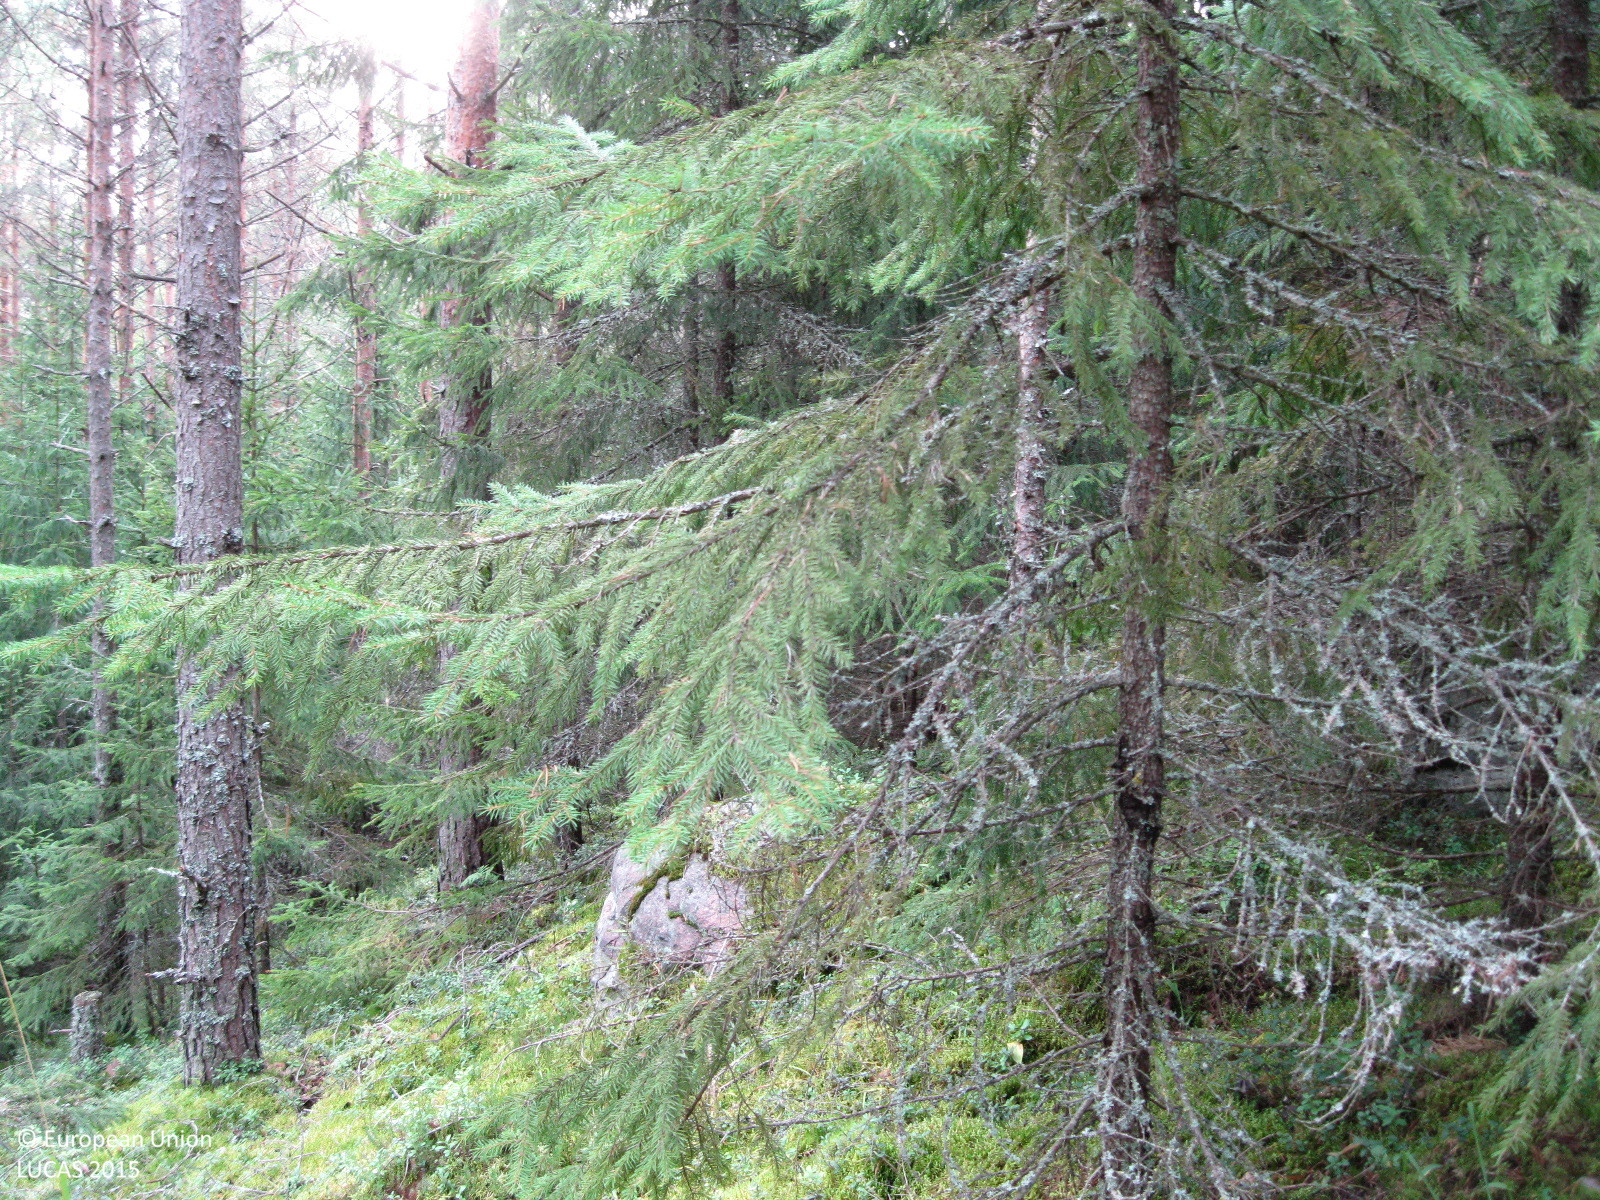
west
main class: Woodland
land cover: Other coniferous woodland
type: boreal forest
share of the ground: 50 - 75 %
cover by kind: coniferous forest trees 60 %, shrubs 15 %, broadleaved forest trees 10 %, lichens and mosses 10 %, herbaceous plants 5 %
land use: Forestry
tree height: > 5 m
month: September
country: FI
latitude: 60.5454
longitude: 24.6764
